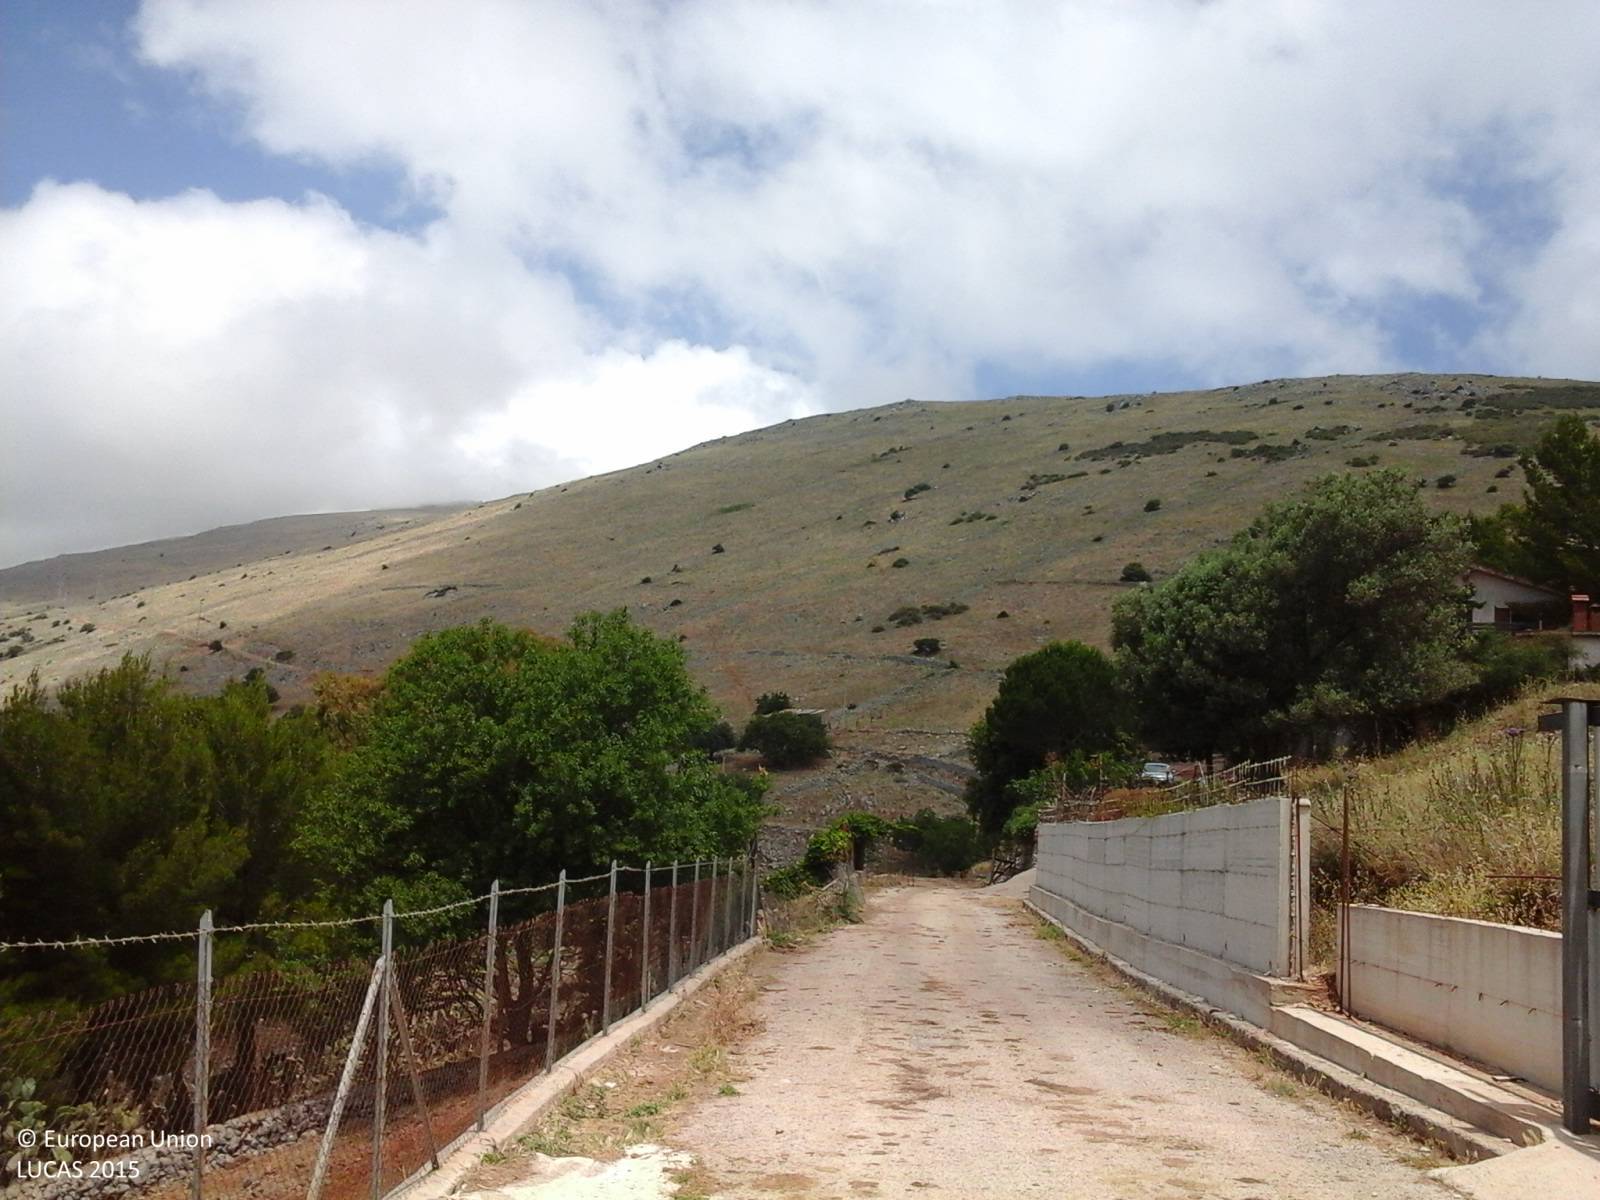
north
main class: Grassland
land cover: Grassland with sparse tree/shrub cover
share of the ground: > 75 %
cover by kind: herbaceous plants 85 %, shrubs 10 %, broadleaved forest trees 5 %
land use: Semi-natural and natural areas not in use
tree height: < 5 m
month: June
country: IT
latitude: 38.1317
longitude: 13.1381
